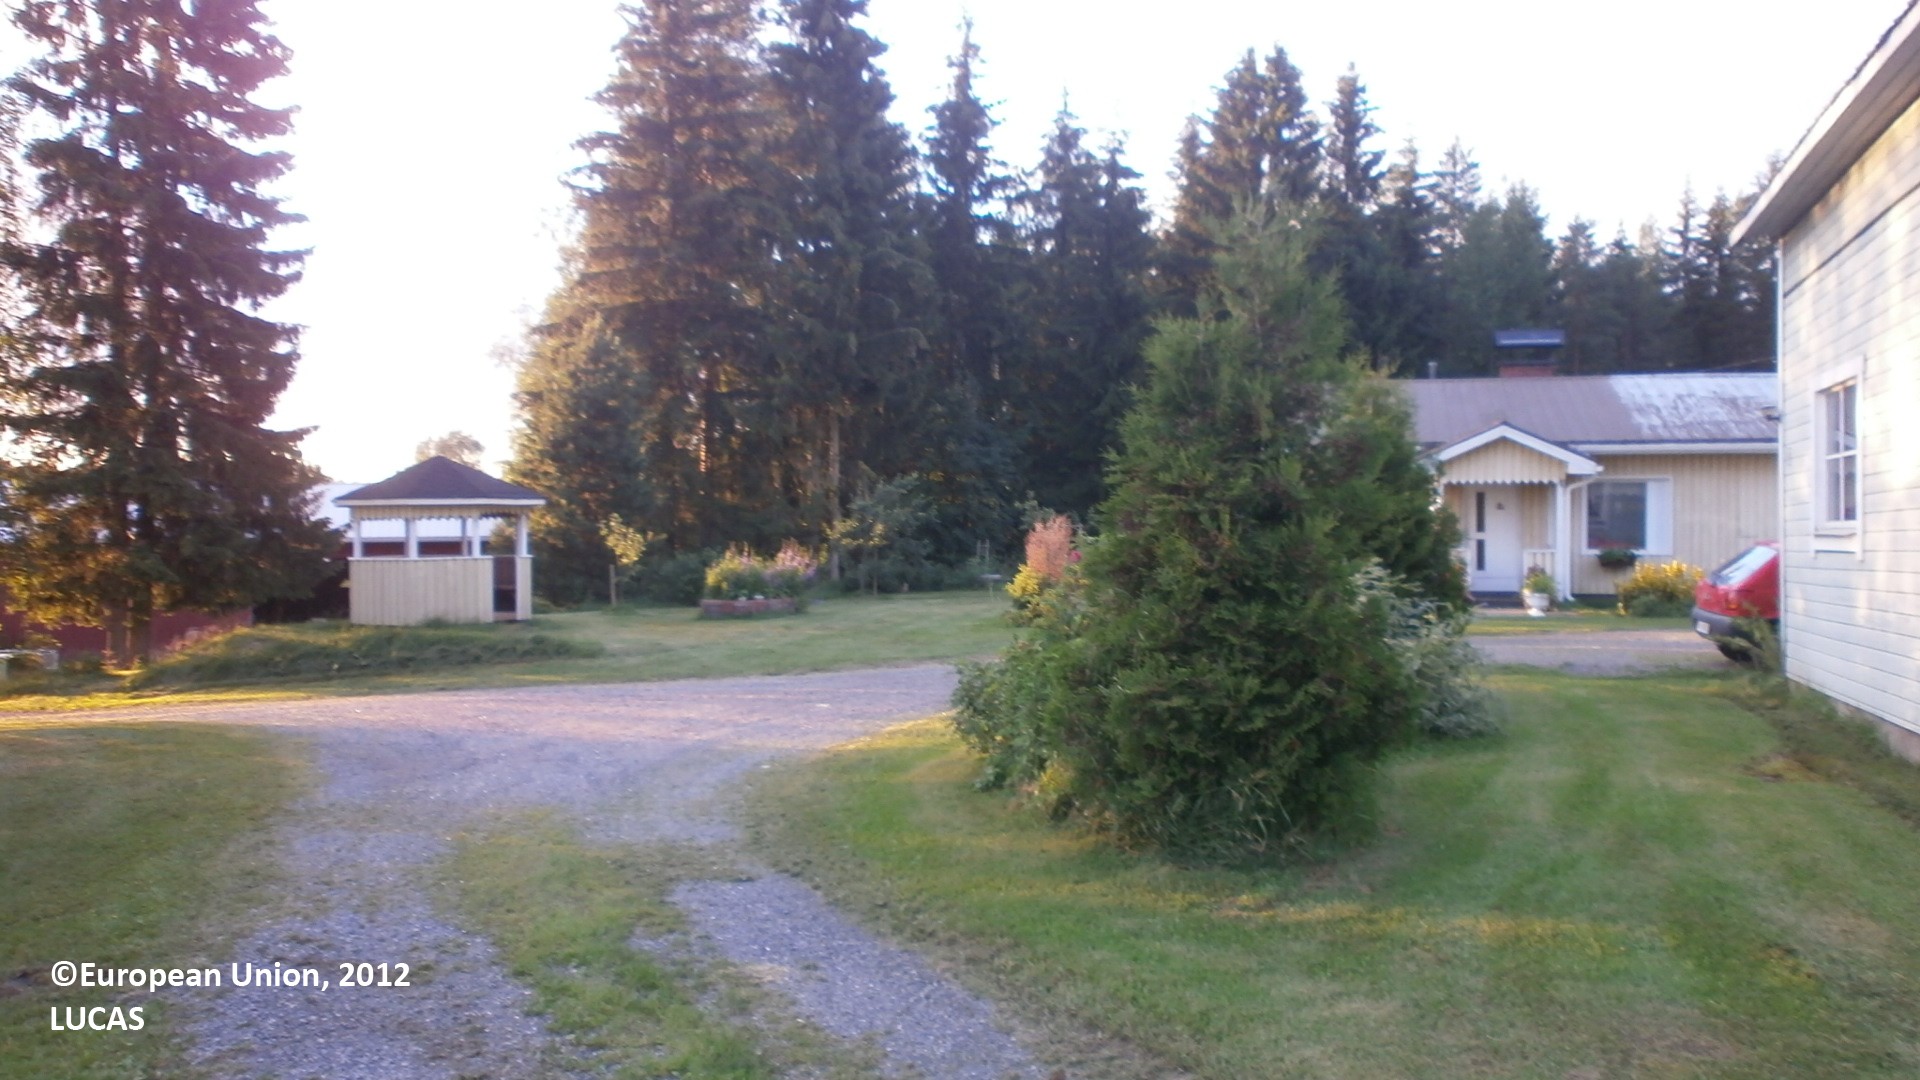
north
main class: Grassland
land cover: Grassland without tree/shrub cover
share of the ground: > 75 %
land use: Residential
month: July
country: FI
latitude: 64.1225
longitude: 24.0080
